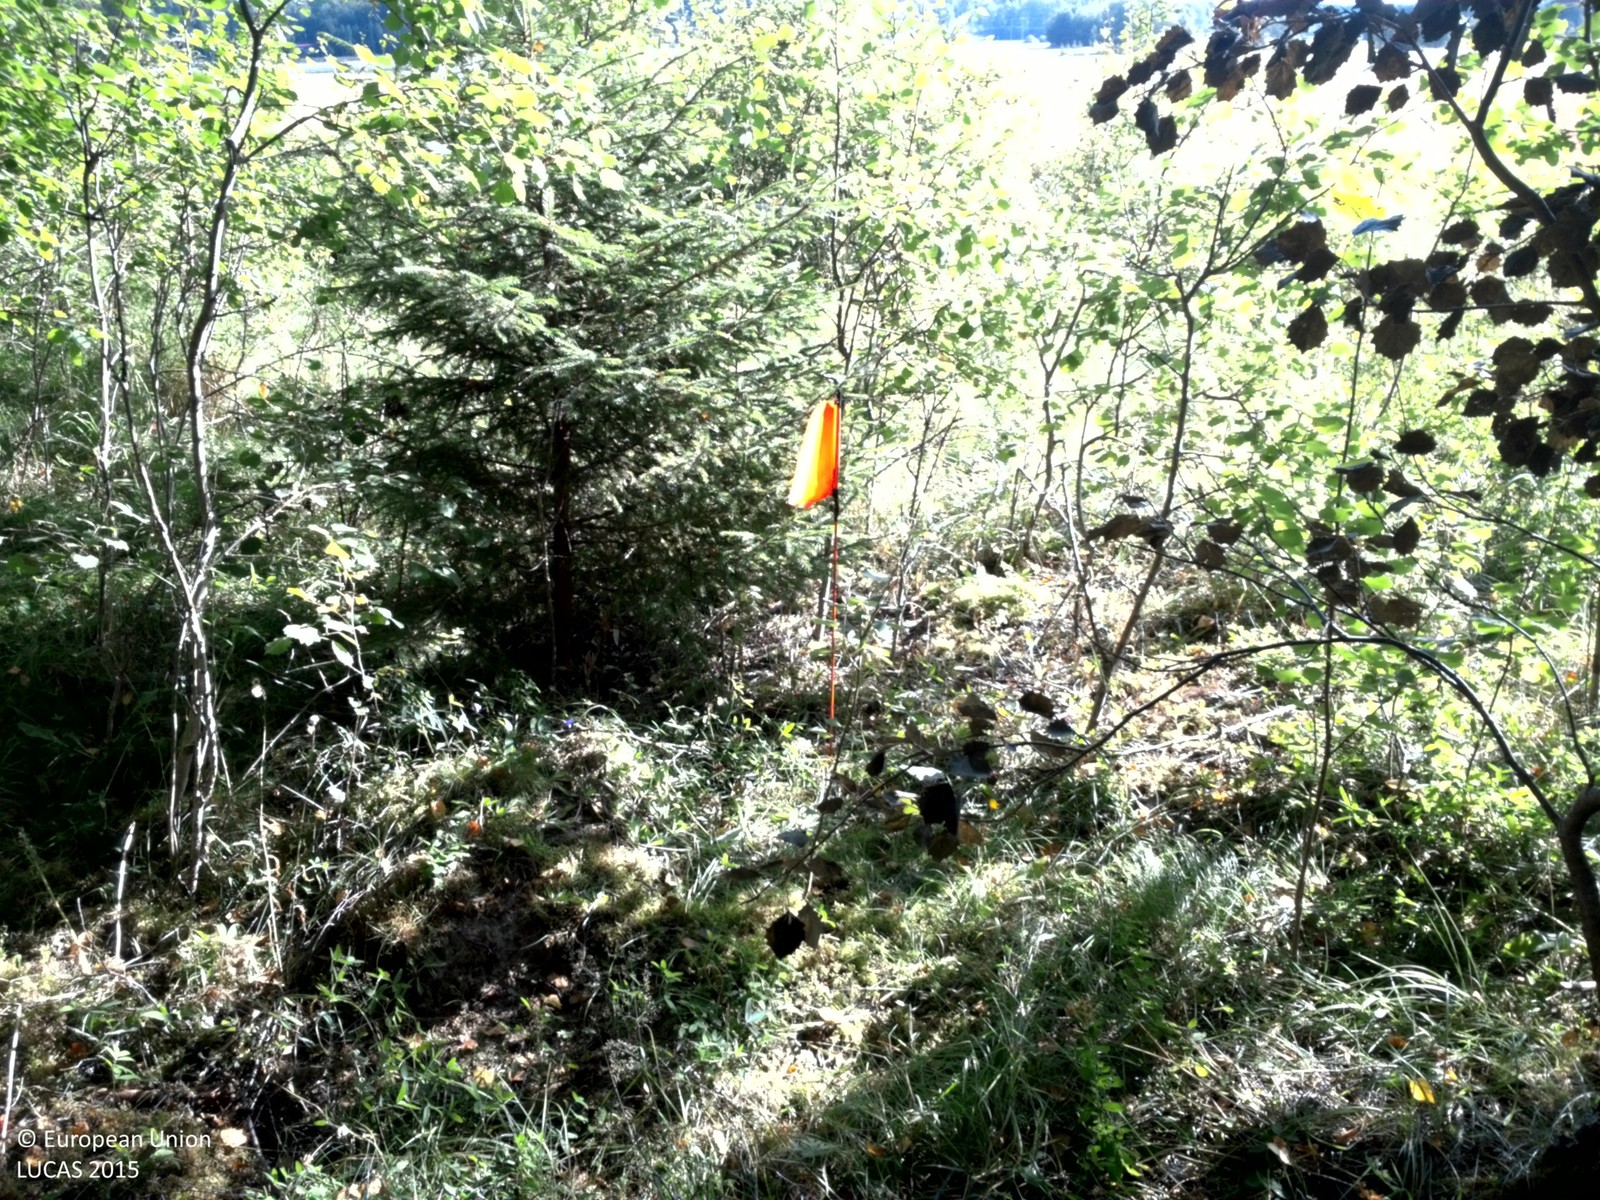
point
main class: Woodland
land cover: Spruce dominated mixed woodland
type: boreal forest
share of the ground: > 75 %
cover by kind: coniferous forest trees 60 %, broadleaved forest trees 20 %, herbaceous plants 20 %
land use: Forestry
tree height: > 5 m
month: August
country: SE
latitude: 59.9172
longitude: 16.9852
